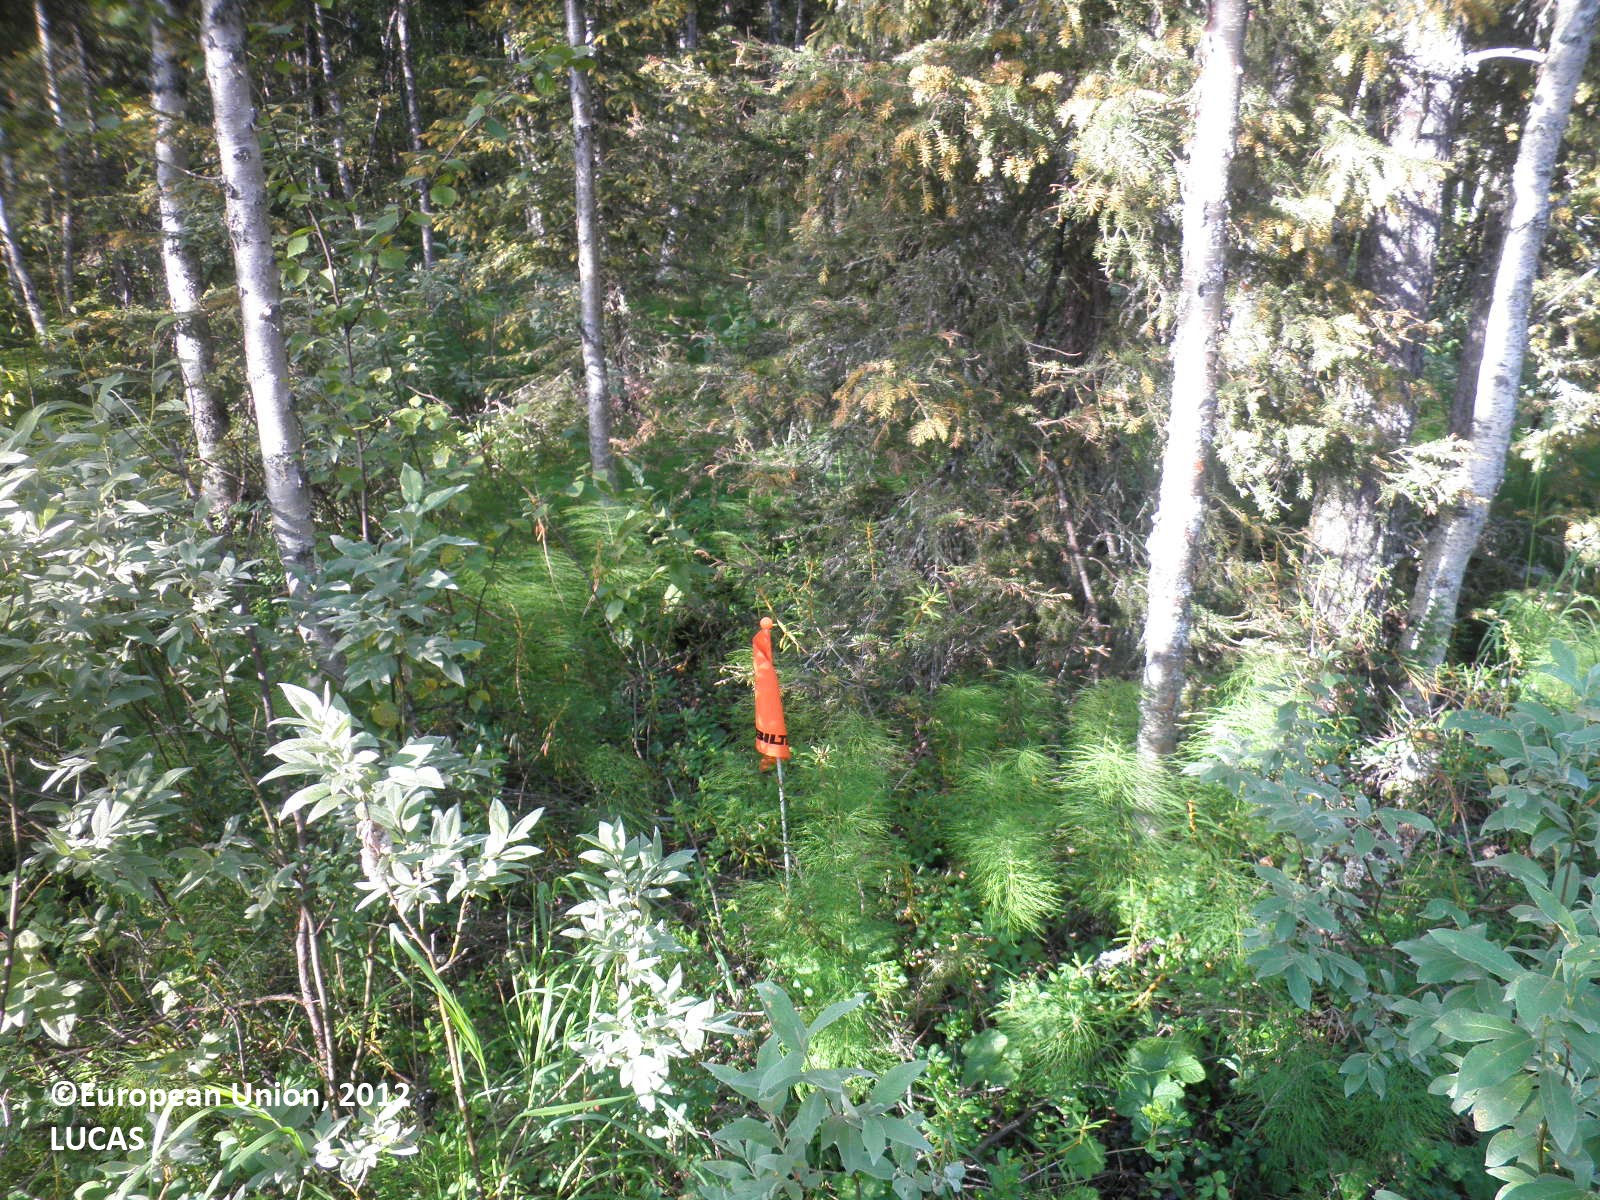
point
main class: Woodland
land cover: Spruce dominated mixed woodland
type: boreal forest
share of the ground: > 75 %
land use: Forestry
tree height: > 5 m
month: August
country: FI
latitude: 67.5382
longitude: 25.5049
